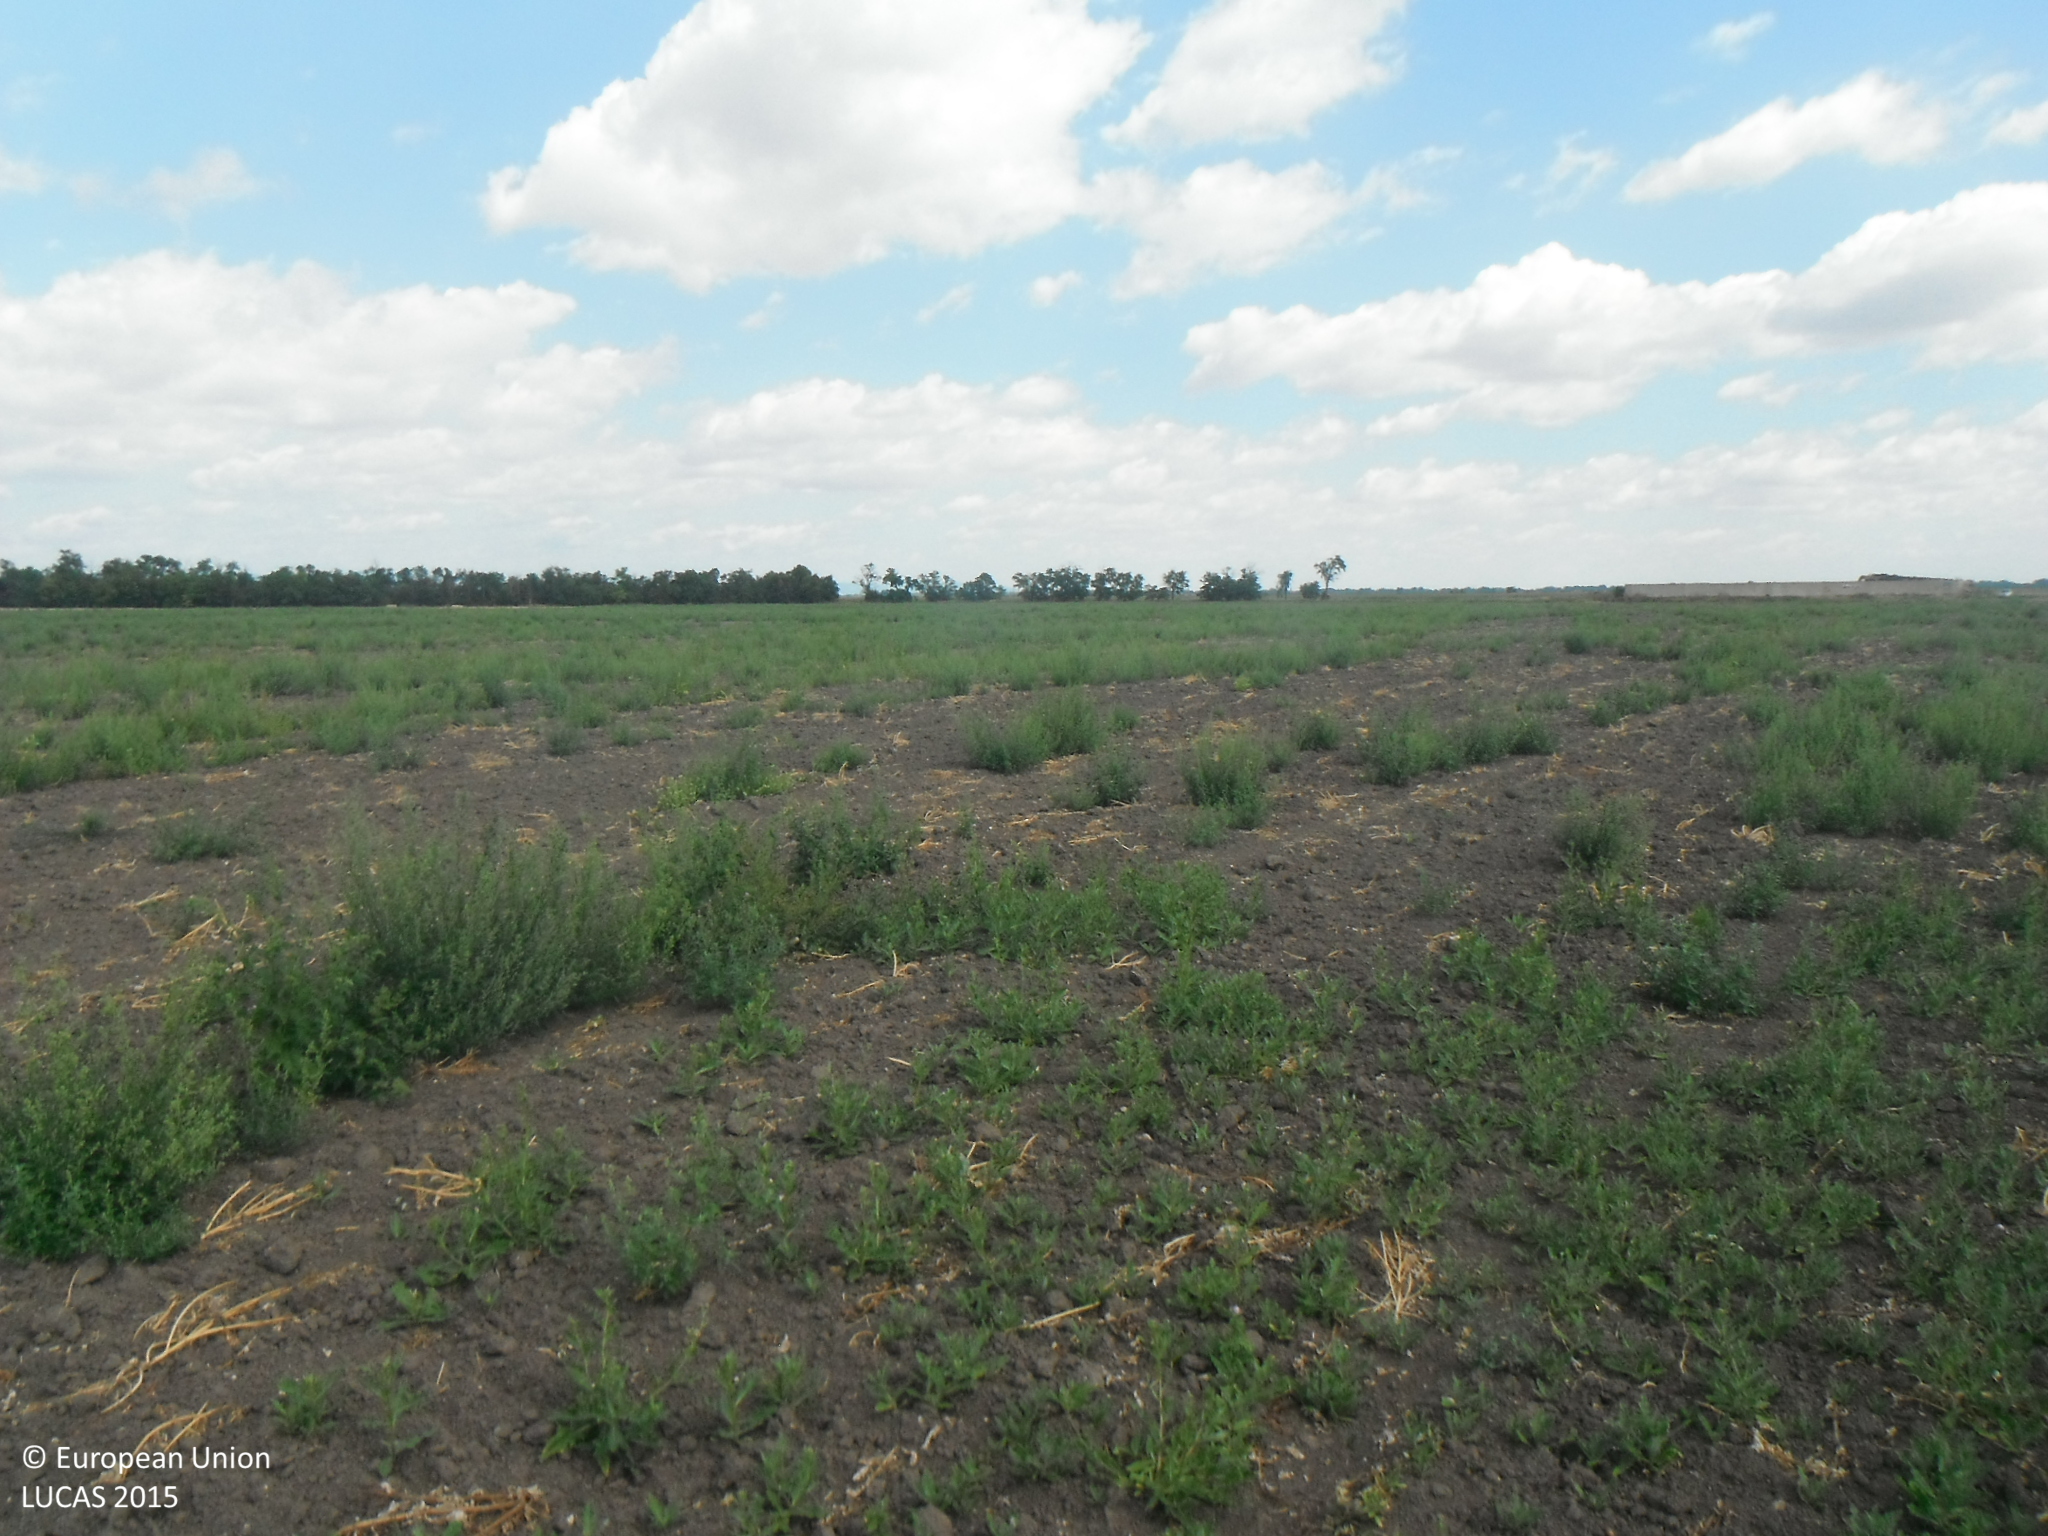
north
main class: Grassland
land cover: Spontaneously vegetated surfaces
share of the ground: 25 - 50 %
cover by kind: unconsolidated bare surface 65 %, herbaceous plants 35 %
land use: Fallow land
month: July
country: SK
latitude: 48.1024
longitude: 17.3817
